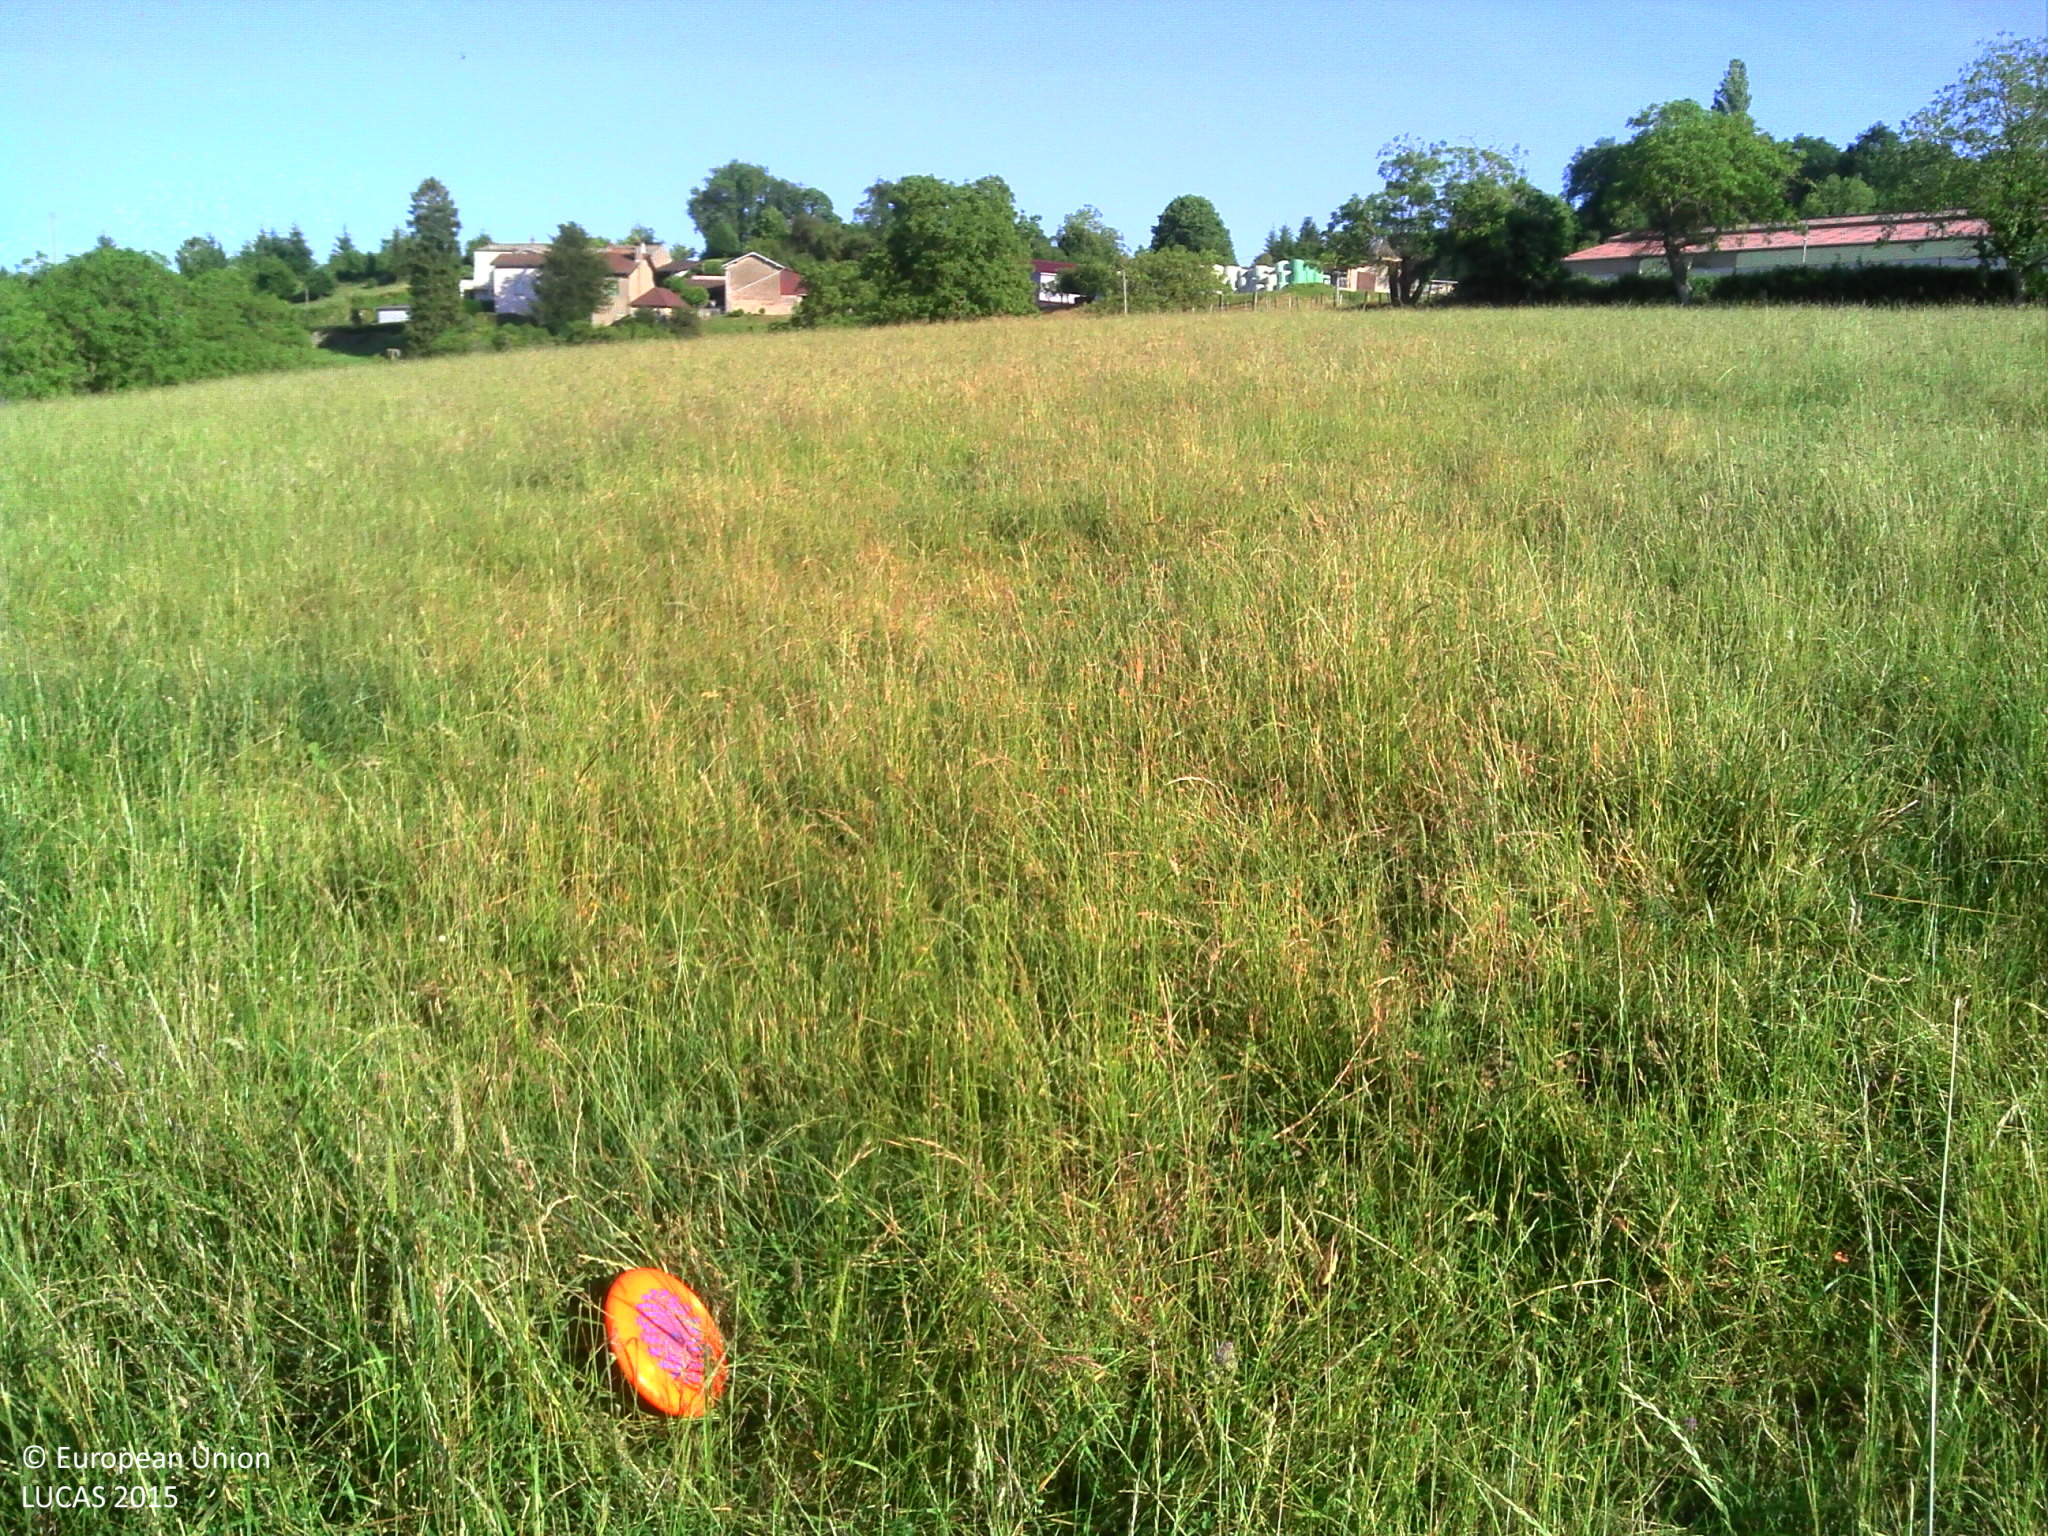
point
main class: Grassland
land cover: Grassland without tree/shrub cover
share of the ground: > 75 %
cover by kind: herbaceous plants 100 %
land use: Agriculture (excluding fallow land and kitchen gardens)
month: June
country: FR
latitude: 46.5712
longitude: 4.8742
